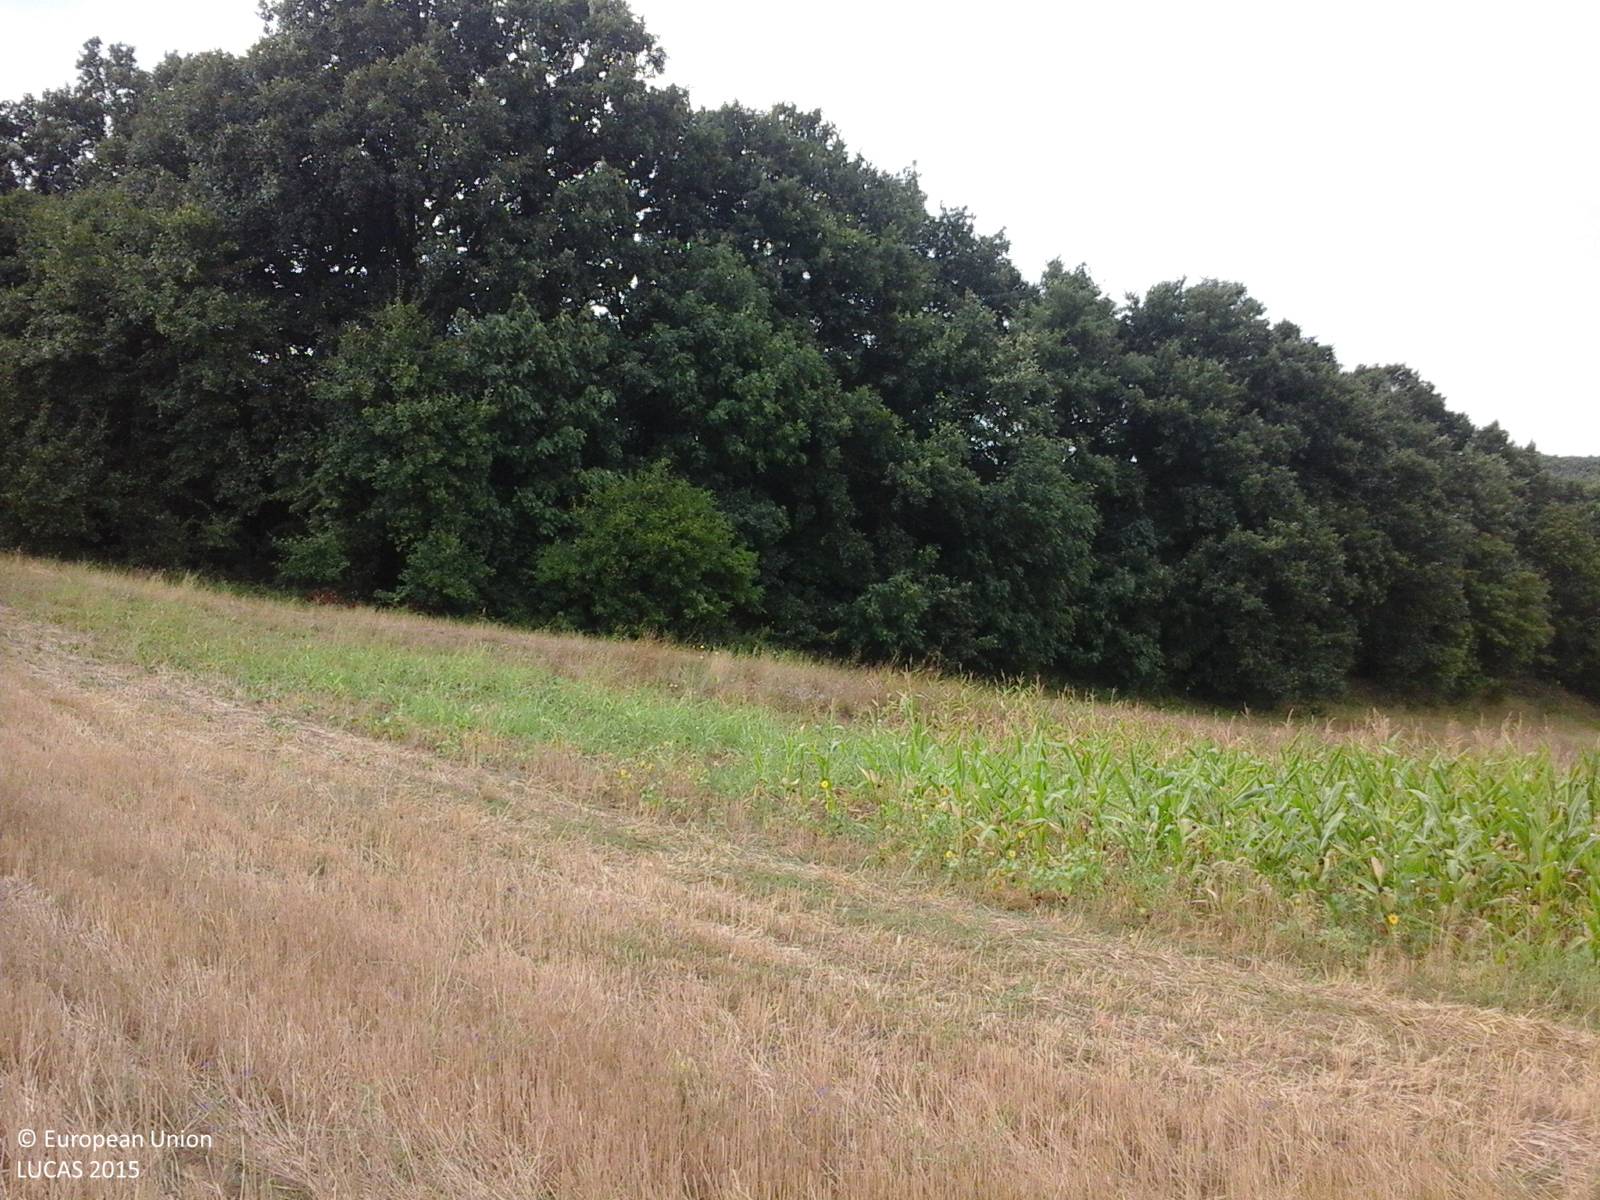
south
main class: Cropland
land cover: Common wheat
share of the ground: > 75 %
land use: Agriculture (excluding fallow land and kitchen gardens)
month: August
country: RO
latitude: 44.0614
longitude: 27.7343
